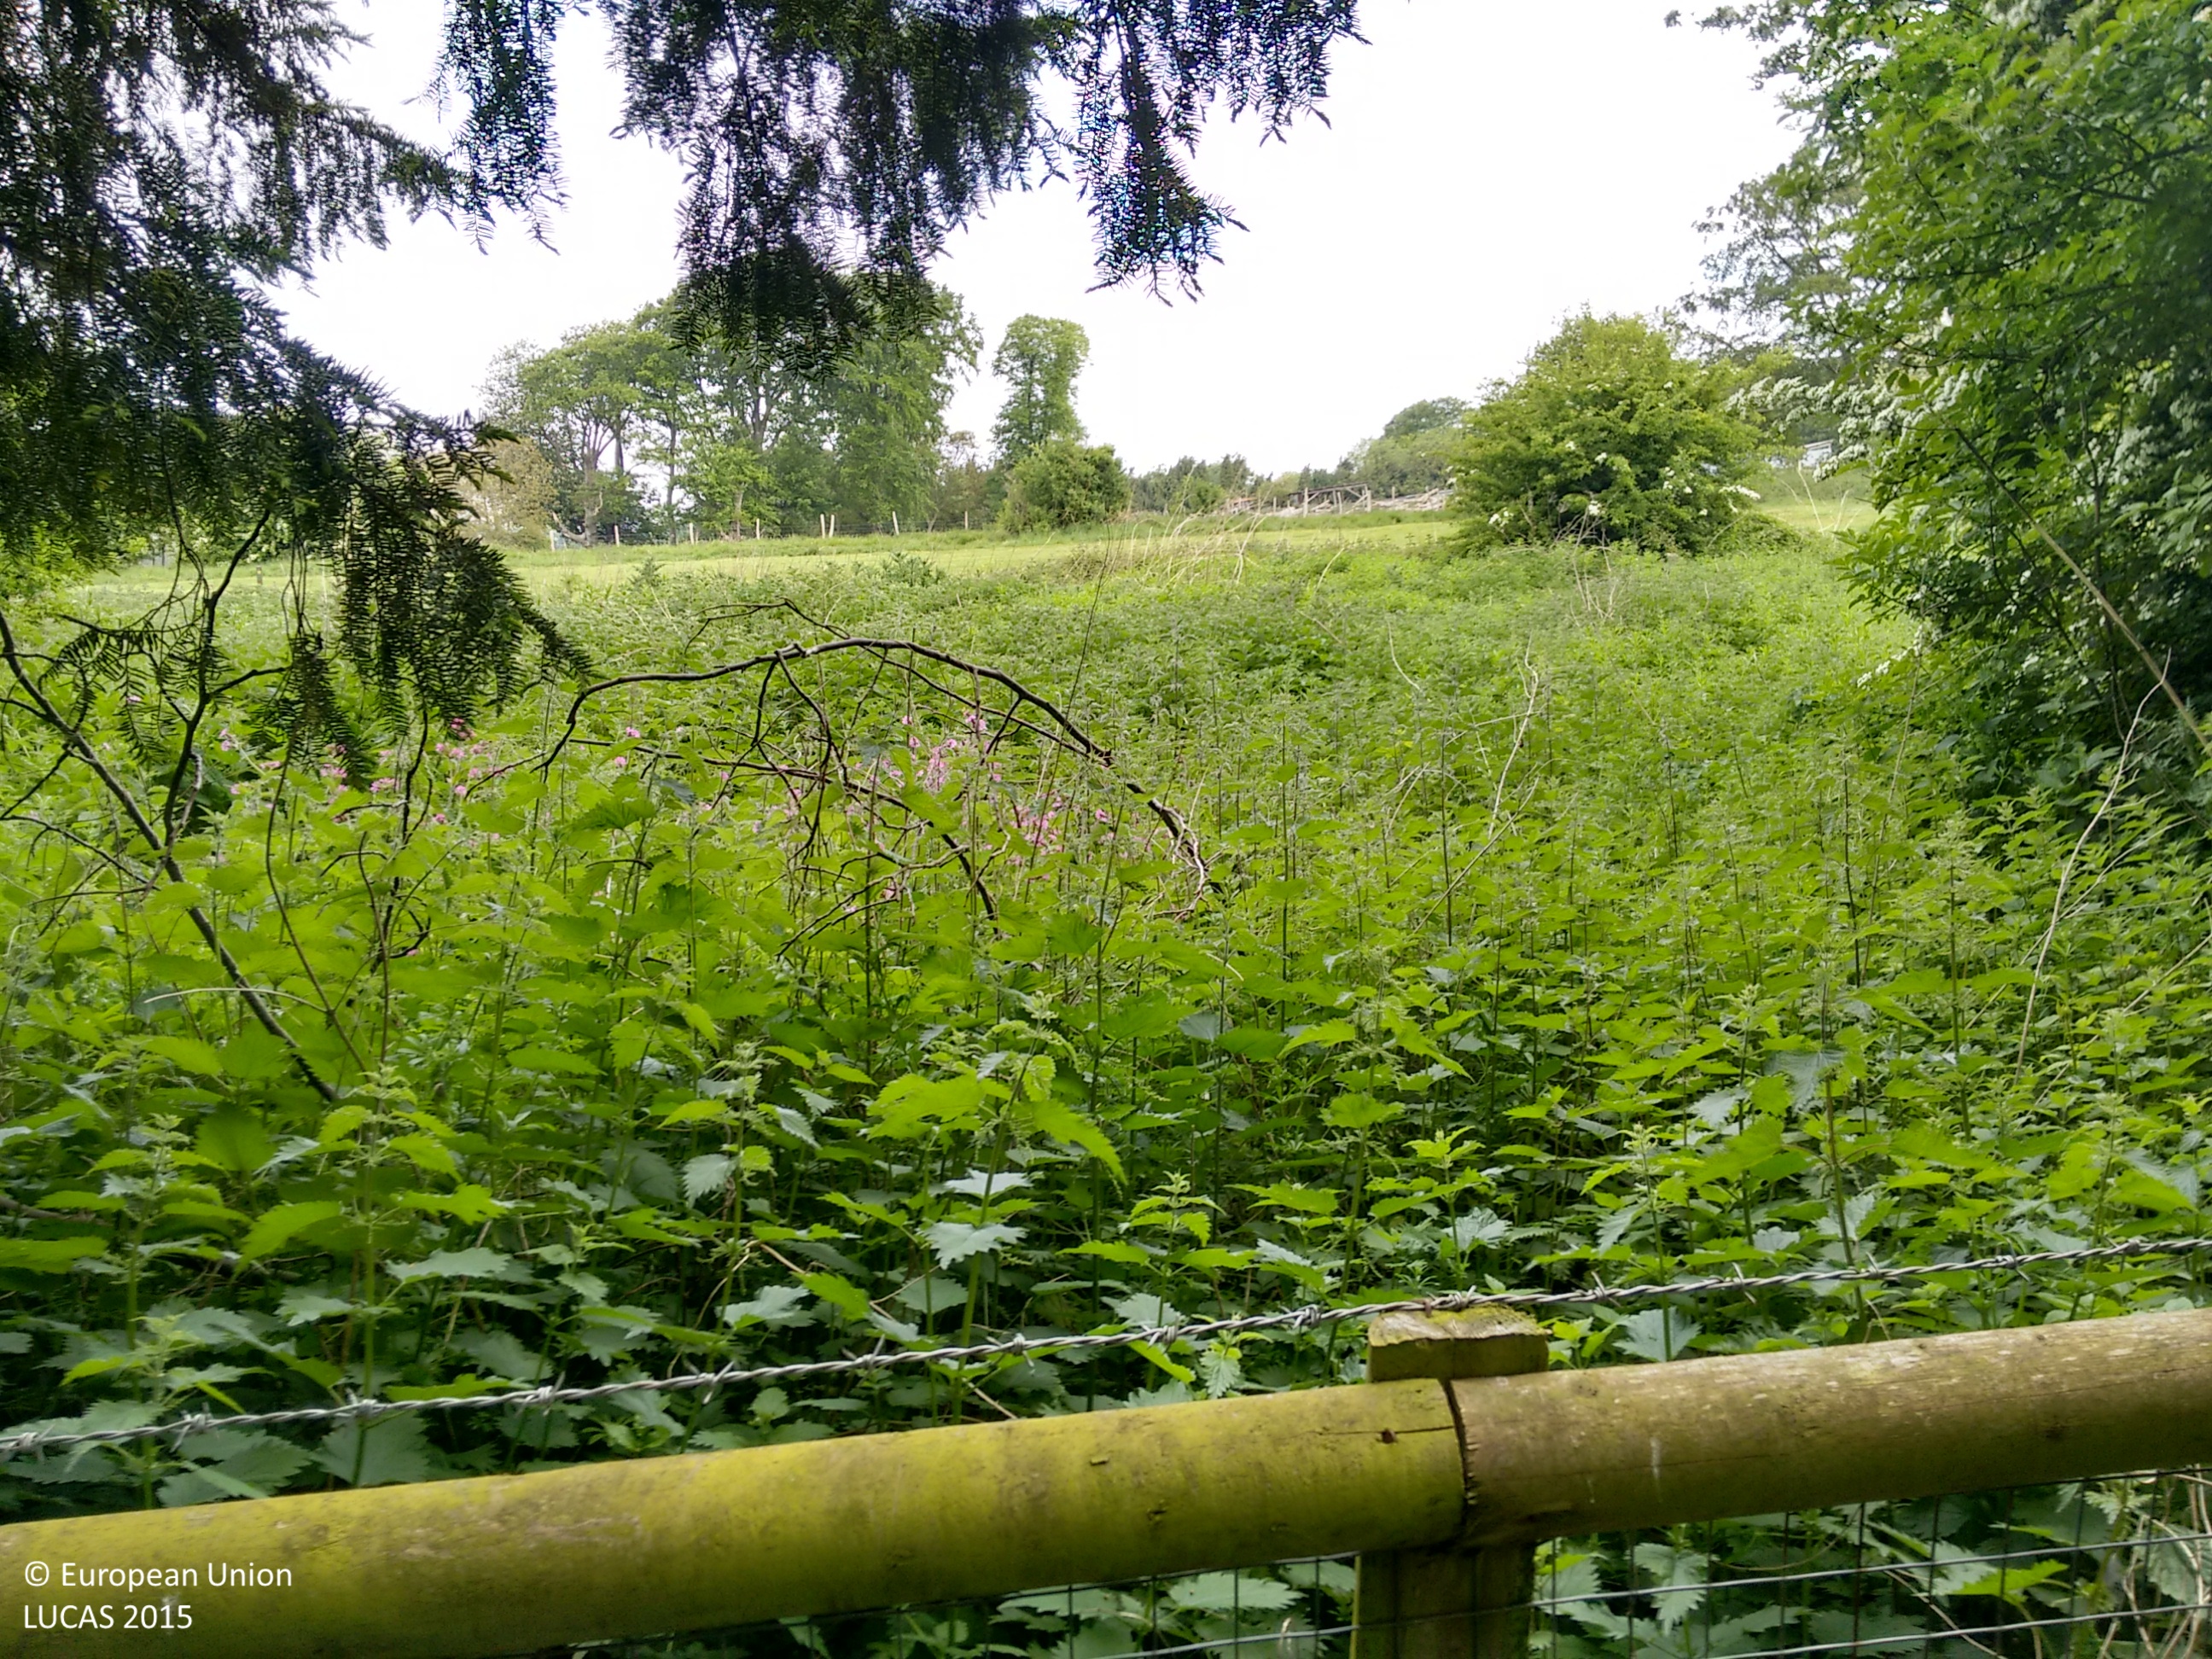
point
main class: Grassland
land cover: Spontaneously vegetated surfaces
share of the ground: > 75 %
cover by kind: herbaceous plants 95 %, shrubs 5 %
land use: Semi-natural and natural areas not in use
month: May
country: GB
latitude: 51.1983
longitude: 1.1768
